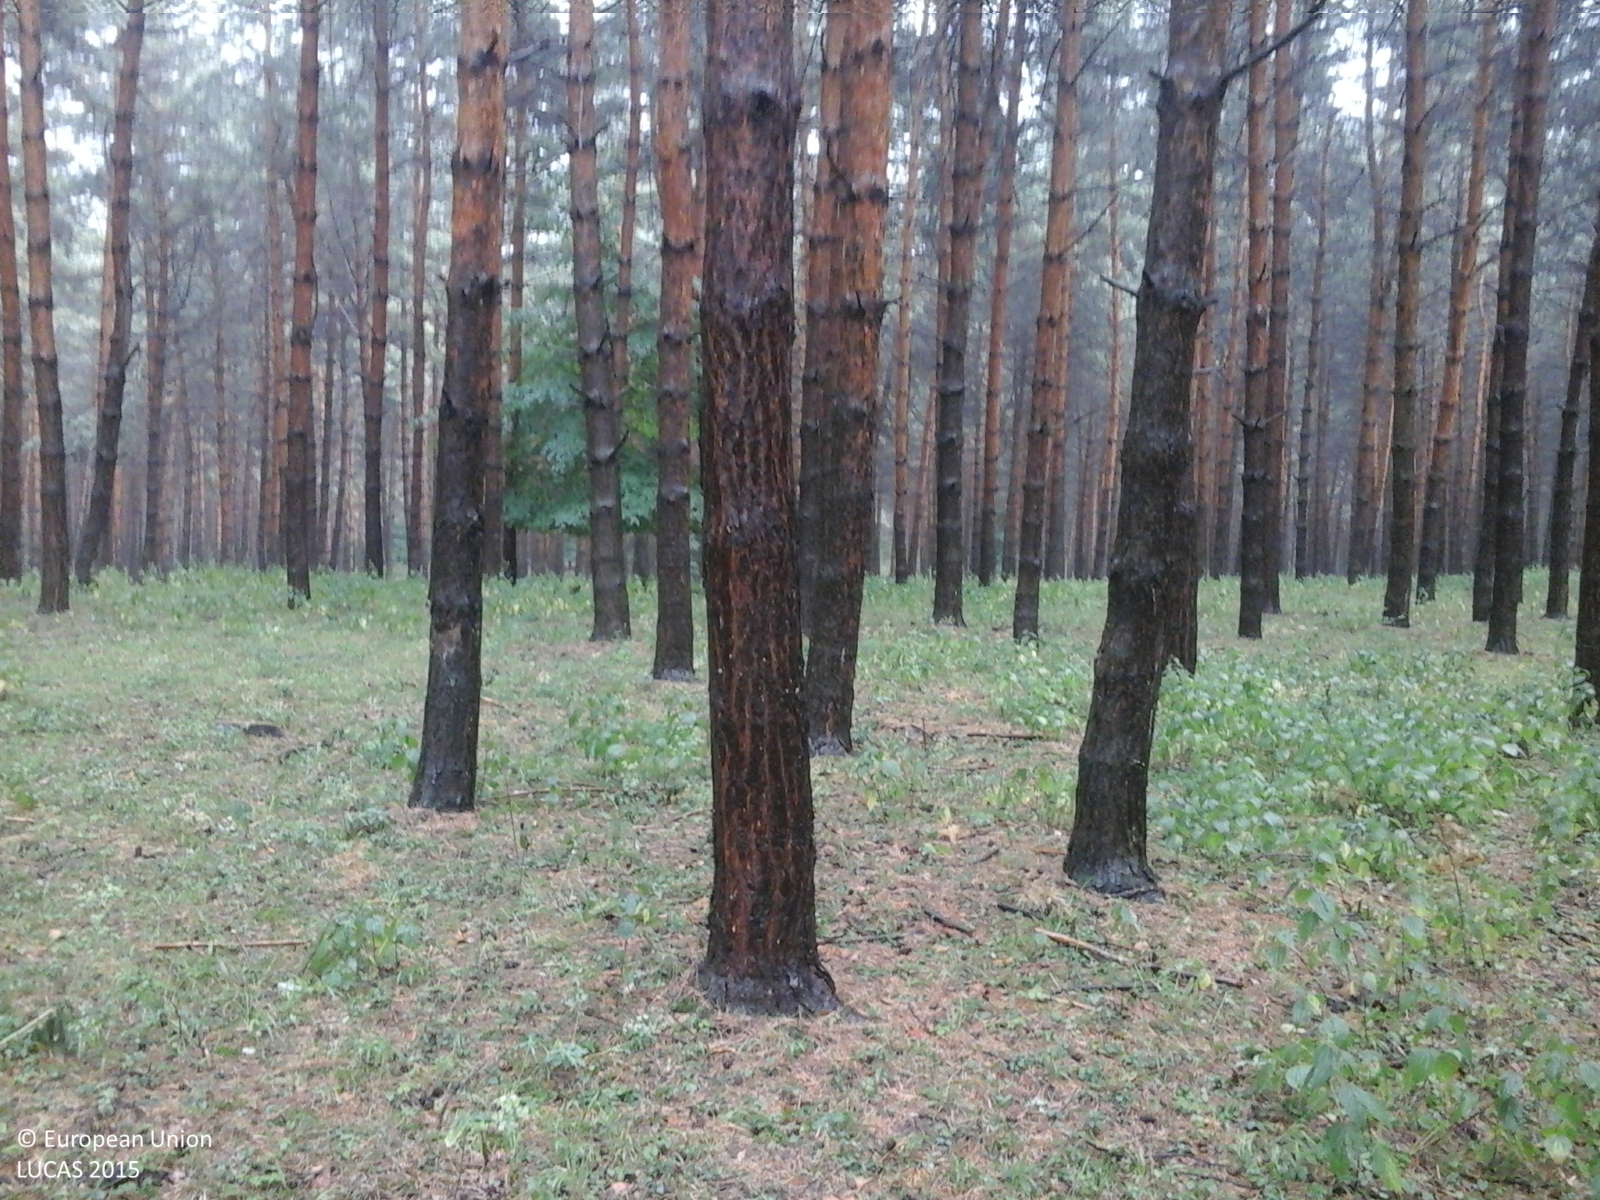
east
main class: Woodland
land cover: Pine dominated coniferous woodland
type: hemiboreal forest and nemoral coniferous forest and mixed broadleaved-coniferous forest
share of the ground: > 75 %
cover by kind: coniferous forest trees 95 %, broadleaved forest trees 5 %
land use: Forestry
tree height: > 5 m
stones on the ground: 10 - 25 %
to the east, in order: Pine dominated coniferous woodland
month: June
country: RO
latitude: 47.3908
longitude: 26.8567
